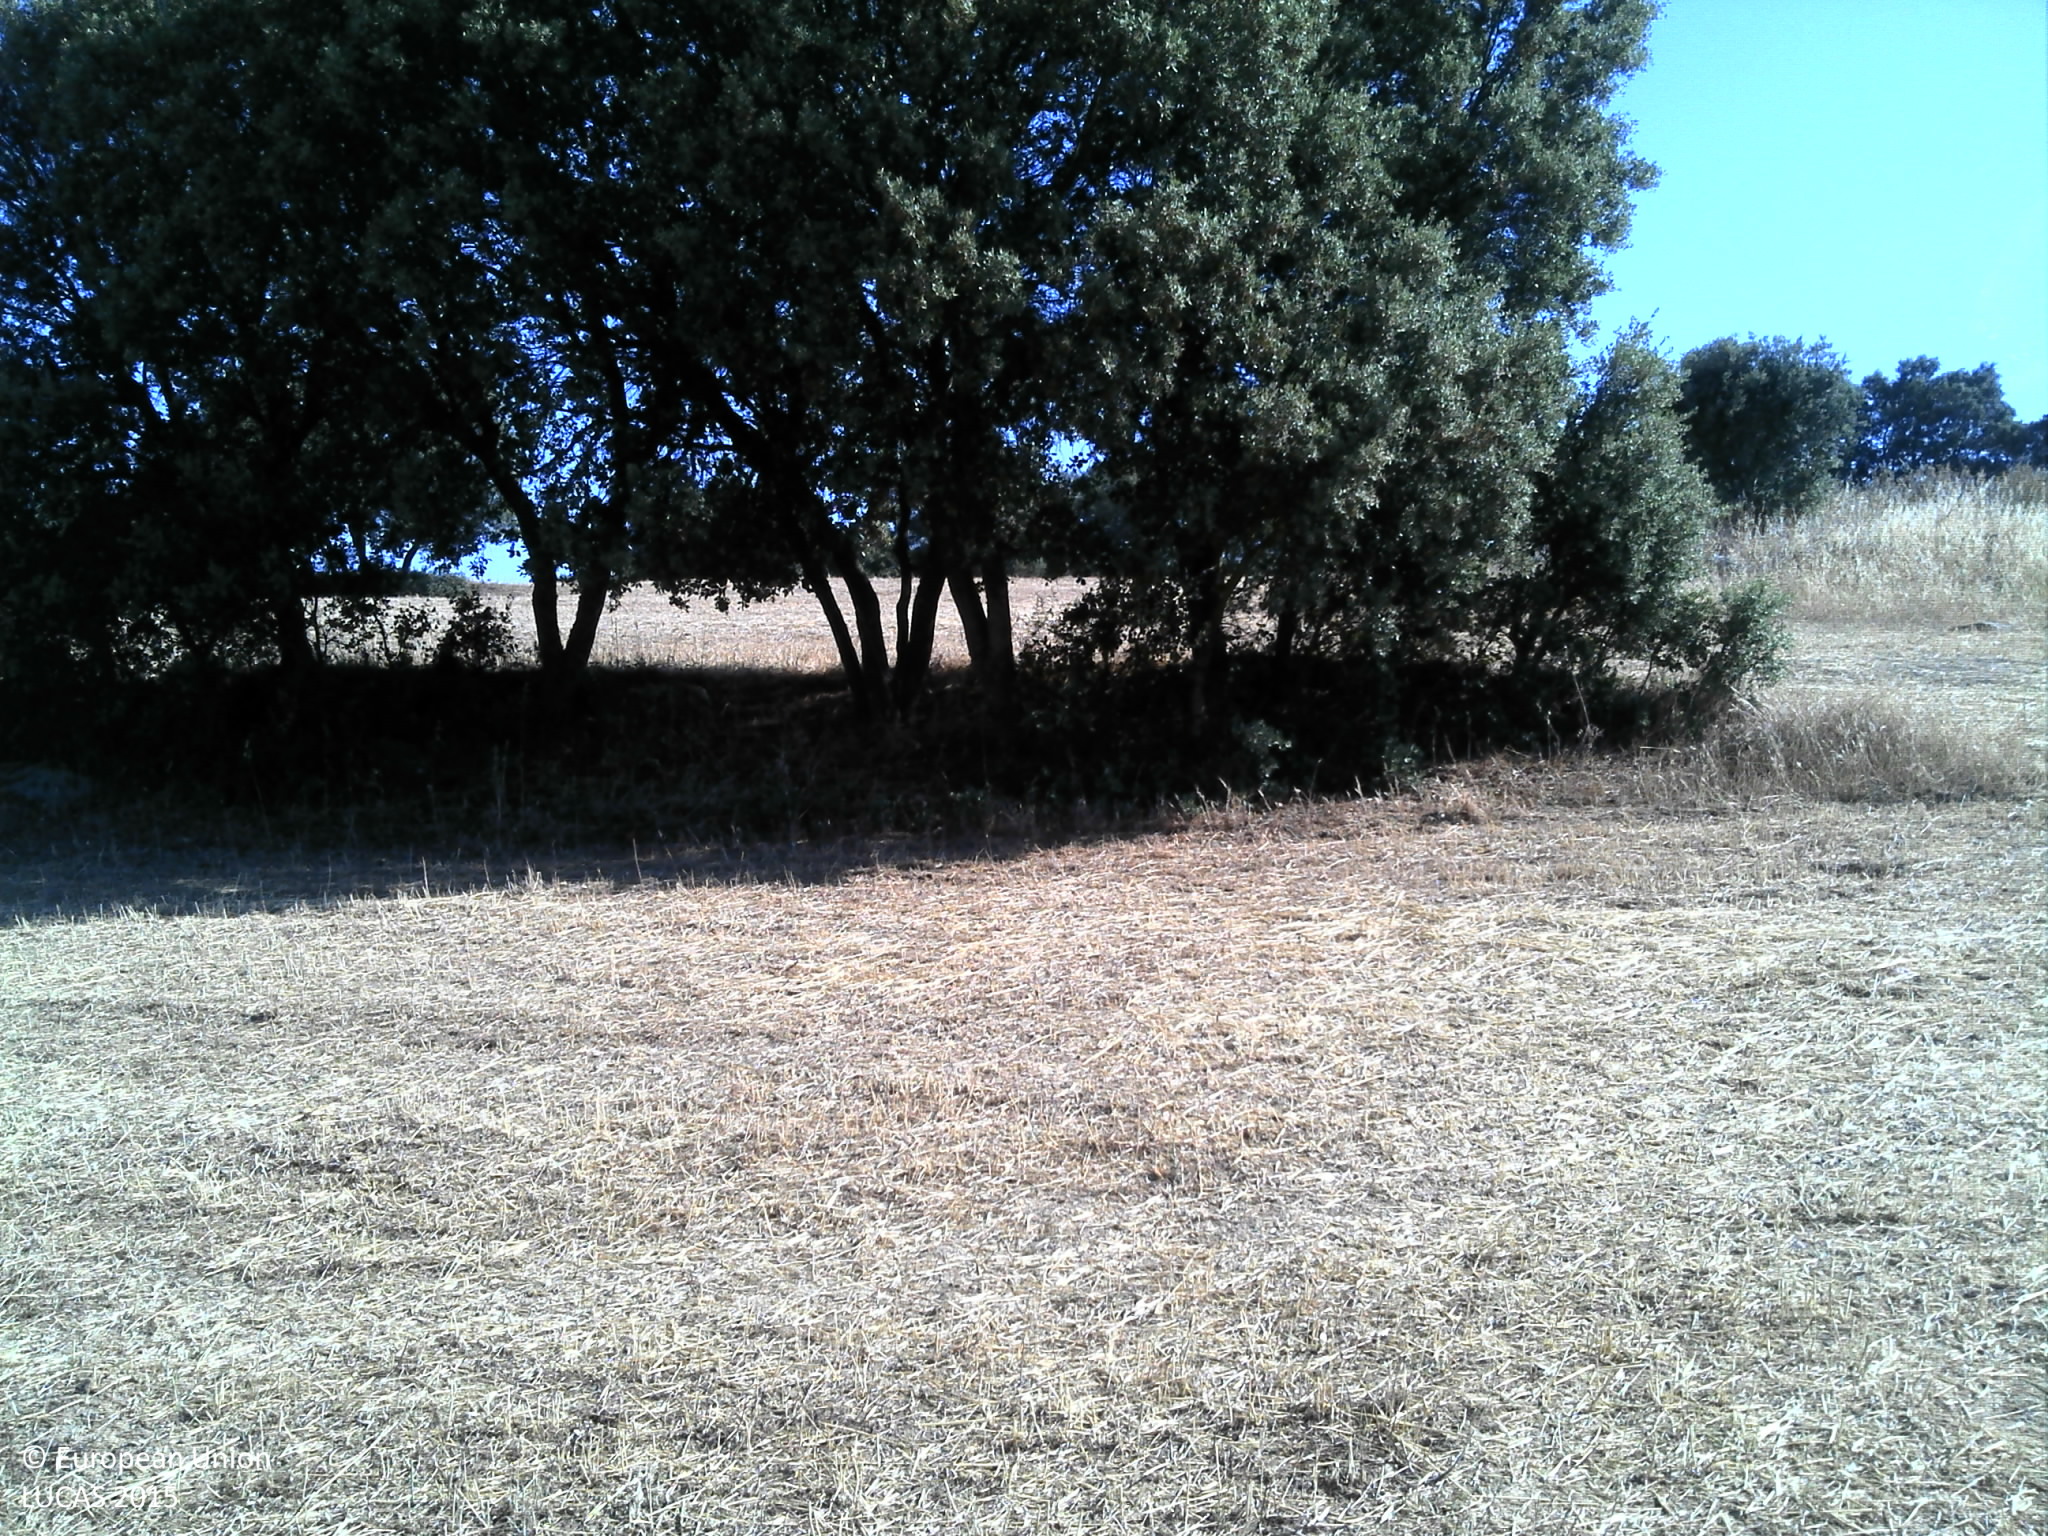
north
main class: Cropland
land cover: Oats
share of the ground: > 75 %
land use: Agriculture (excluding fallow land and kitchen gardens)
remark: Harvested field
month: June
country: PT
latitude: 40.8460
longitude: -6.8363
